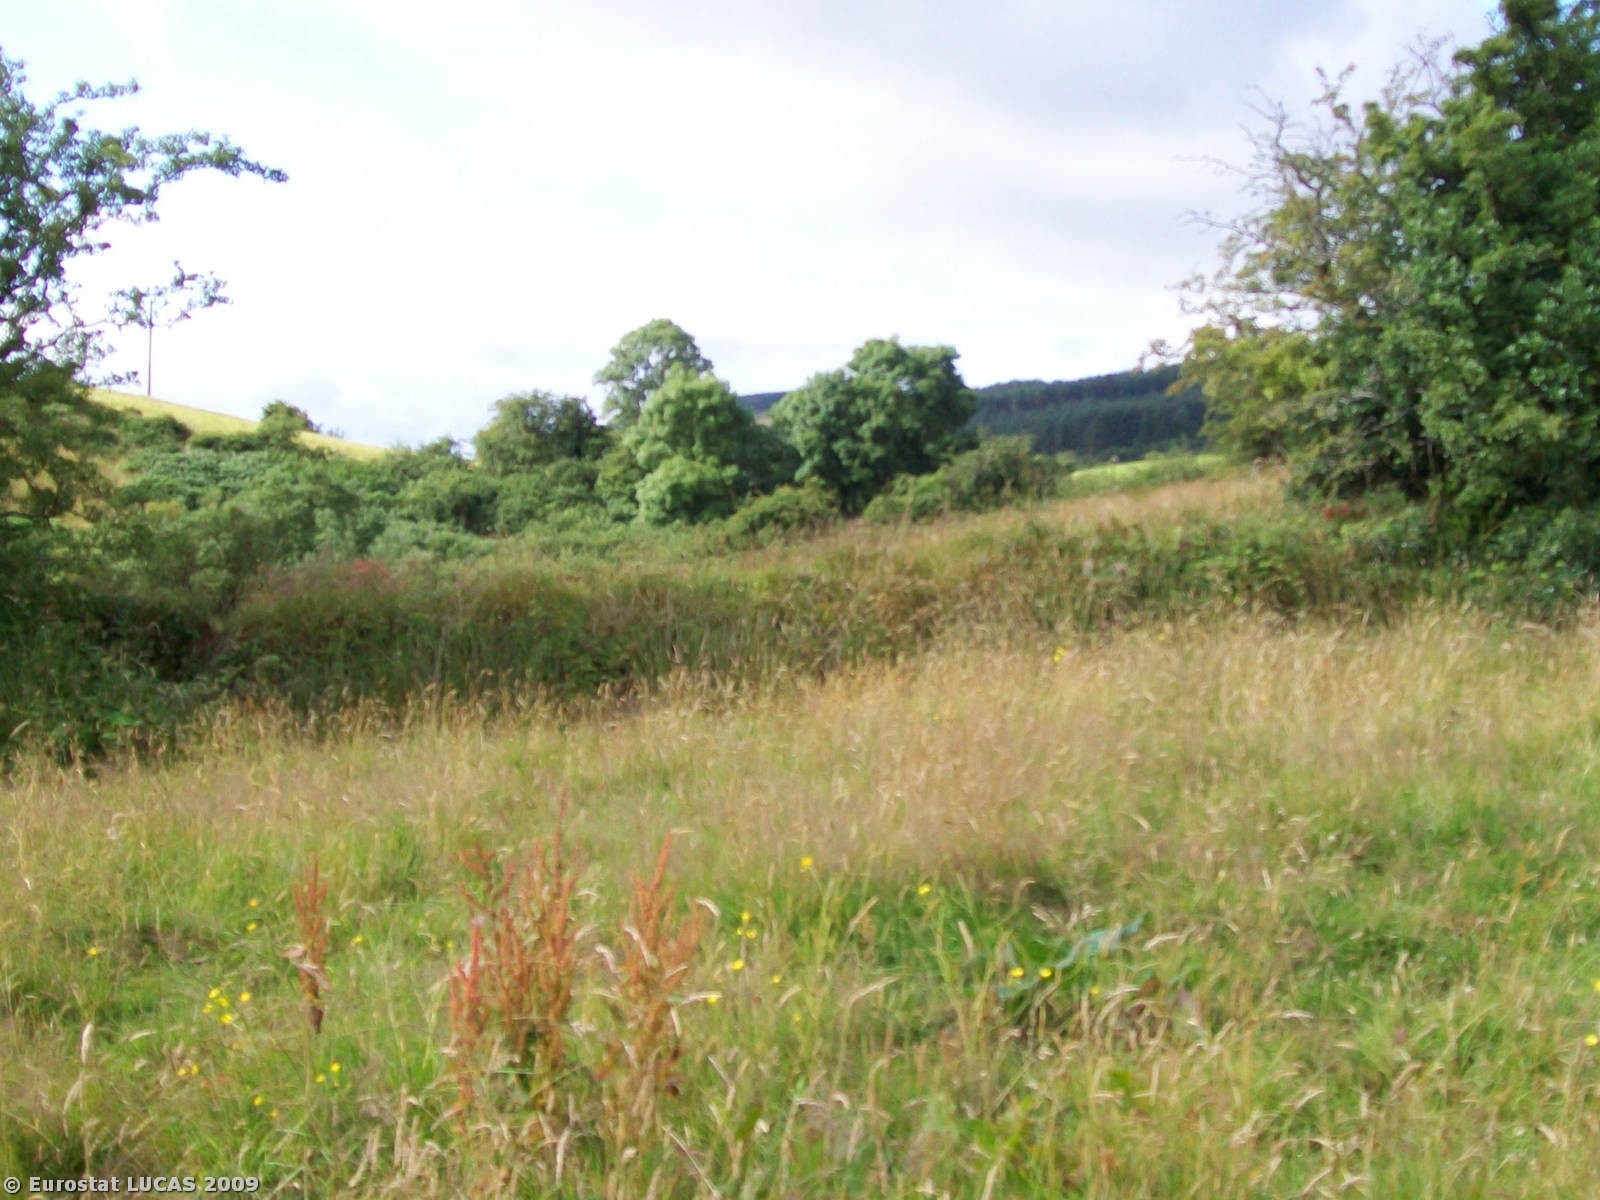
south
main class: Grassland
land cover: Grassland without tree/shrub cover
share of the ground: > 75 %
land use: Agriculture (excluding fallow land and kitchen gardens)
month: July
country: IE
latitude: 53.8498
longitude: -9.0477
